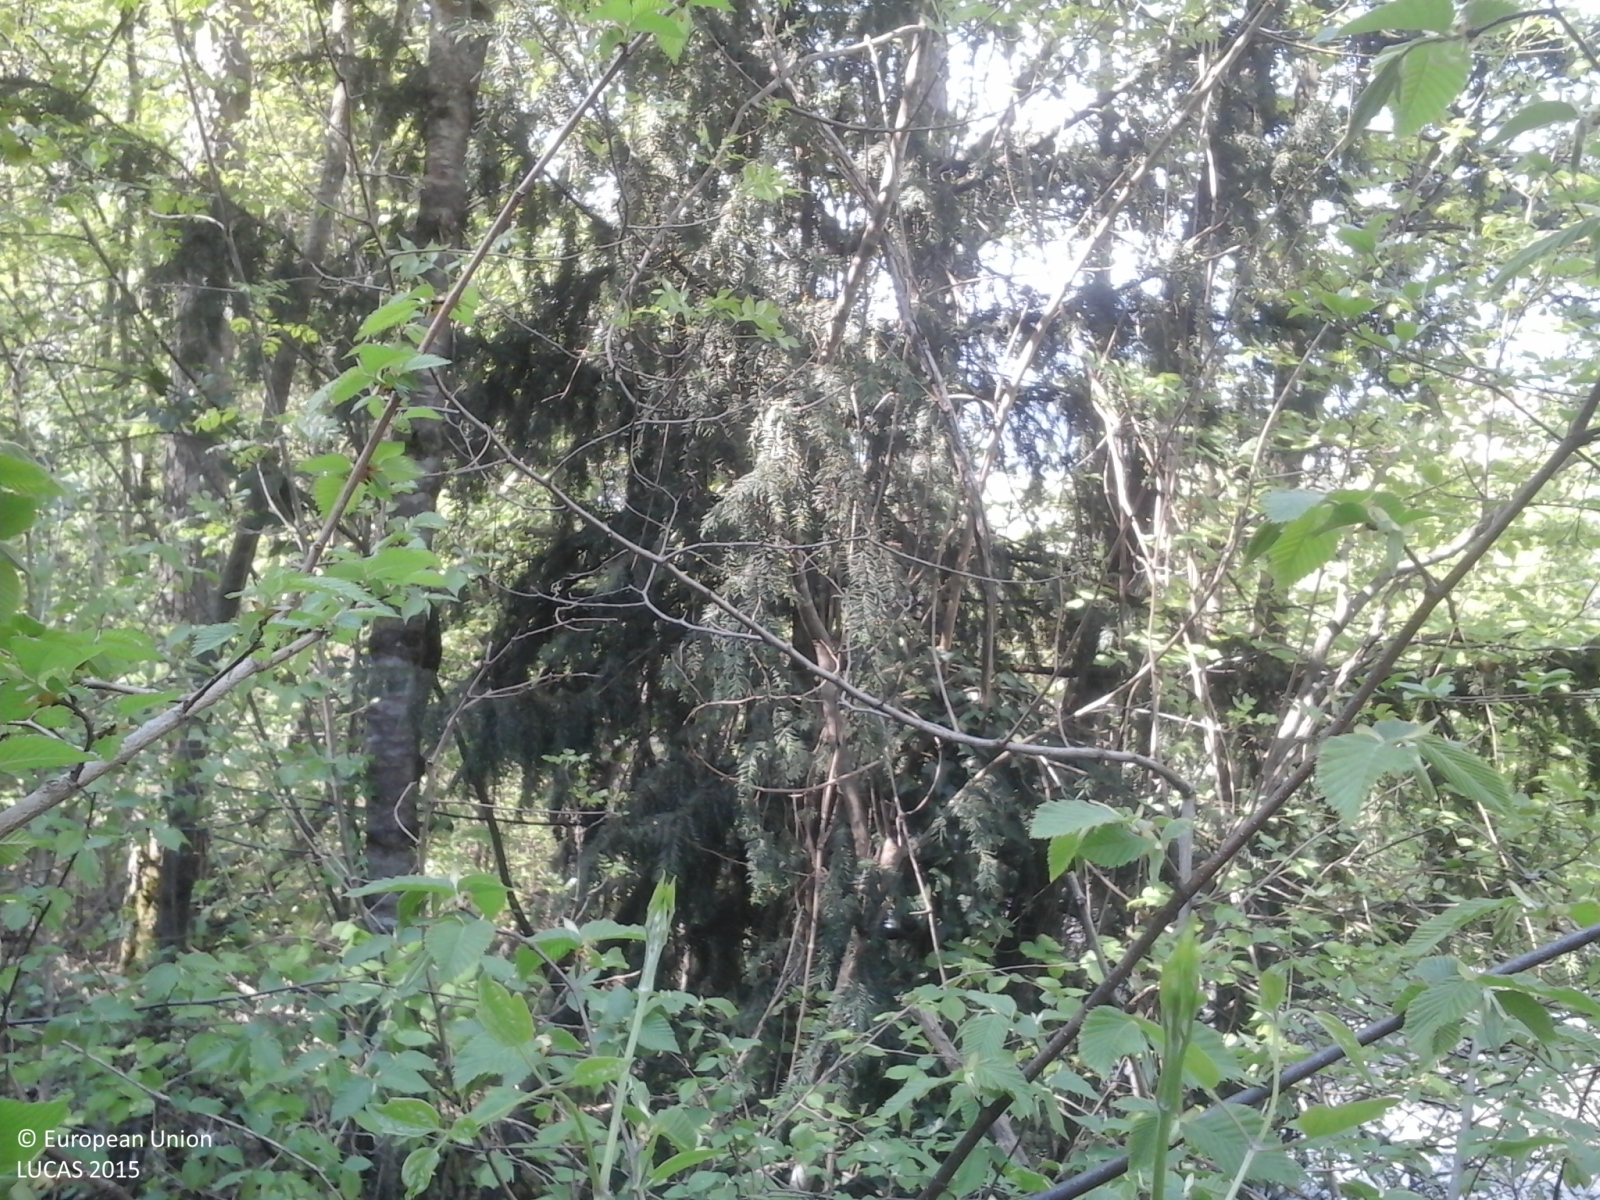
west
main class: Woodland
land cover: Broadleaved woodland
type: thermophilous deciduous forest
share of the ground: > 75 %
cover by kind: broadleaved forest trees 90 %, coniferous forest trees 10 %
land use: Forestry
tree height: > 5 m
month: April
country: IT
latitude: 46.3638
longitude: 11.0774
